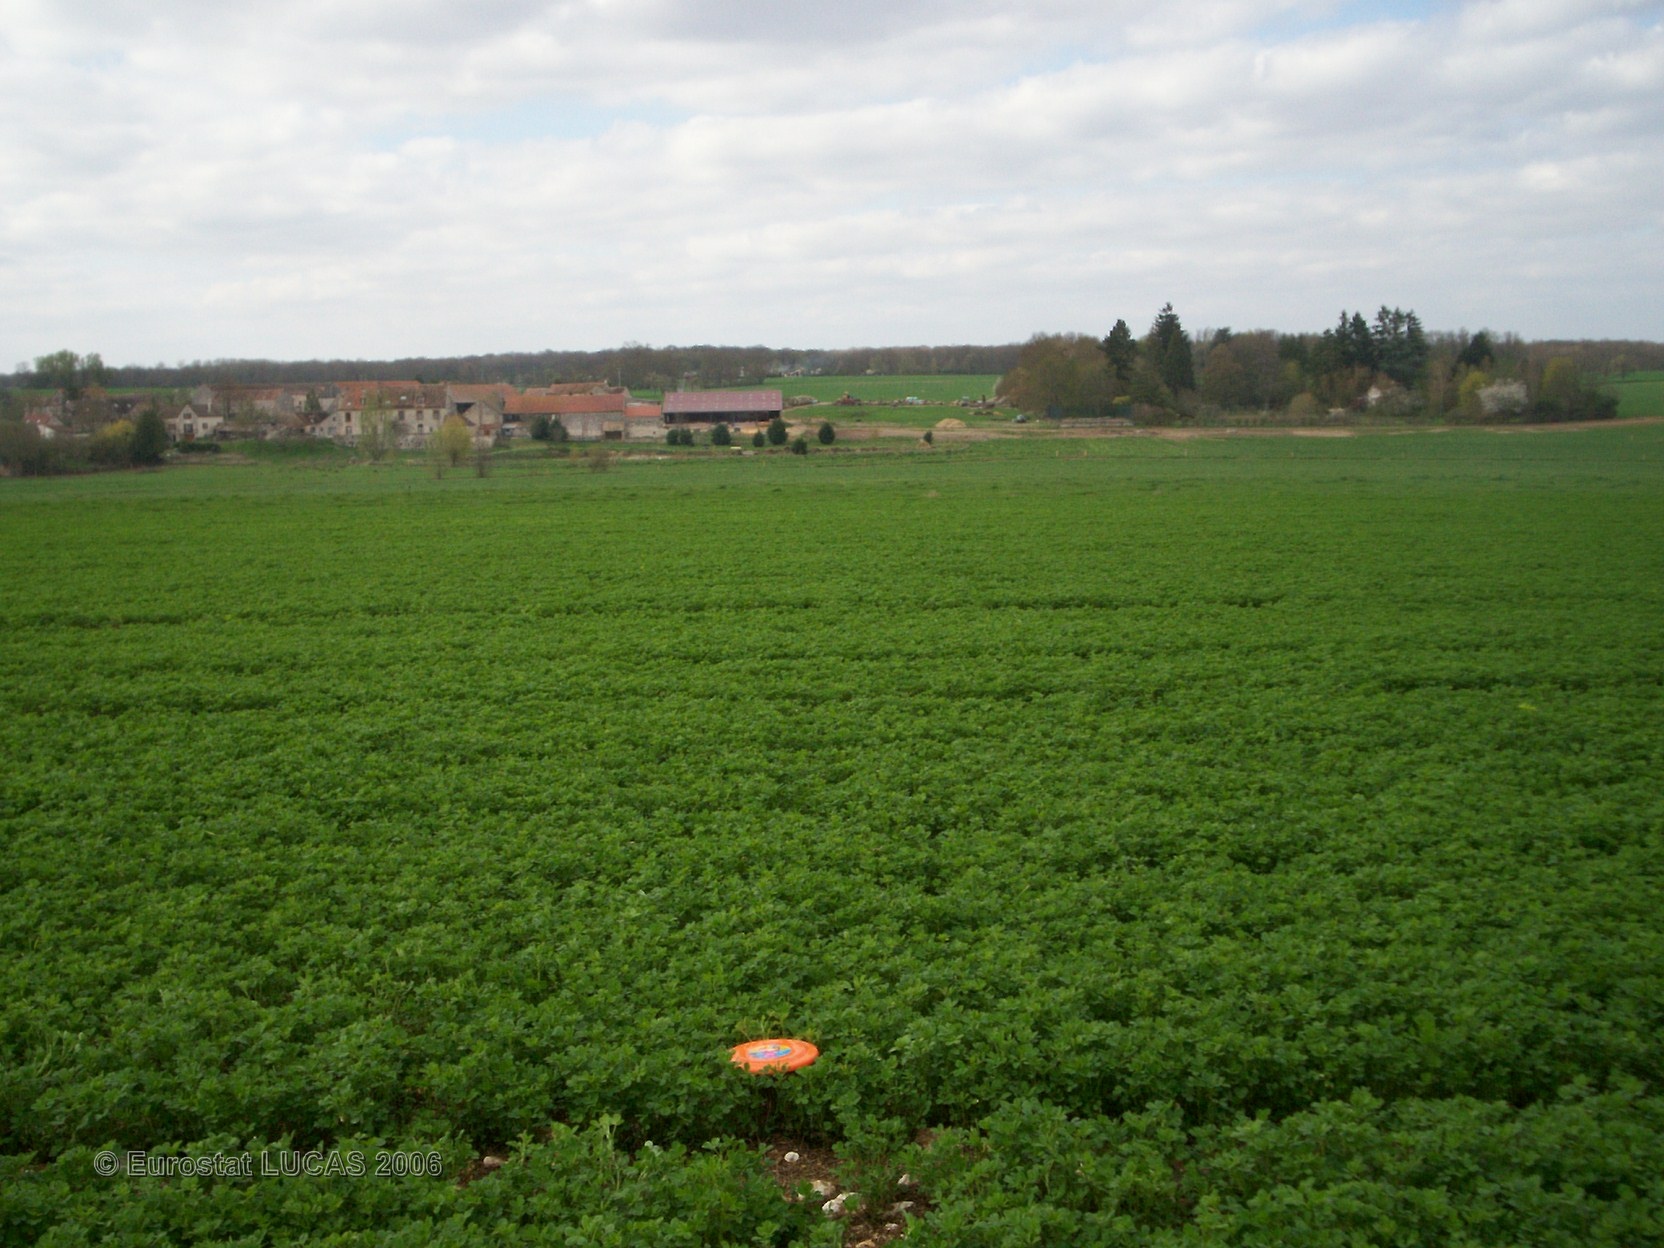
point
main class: Cropland
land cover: Lucerne
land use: Agriculture (excluding fallow land and kitchen gardens)
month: April
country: FR
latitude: 48.4474
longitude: 2.9208
